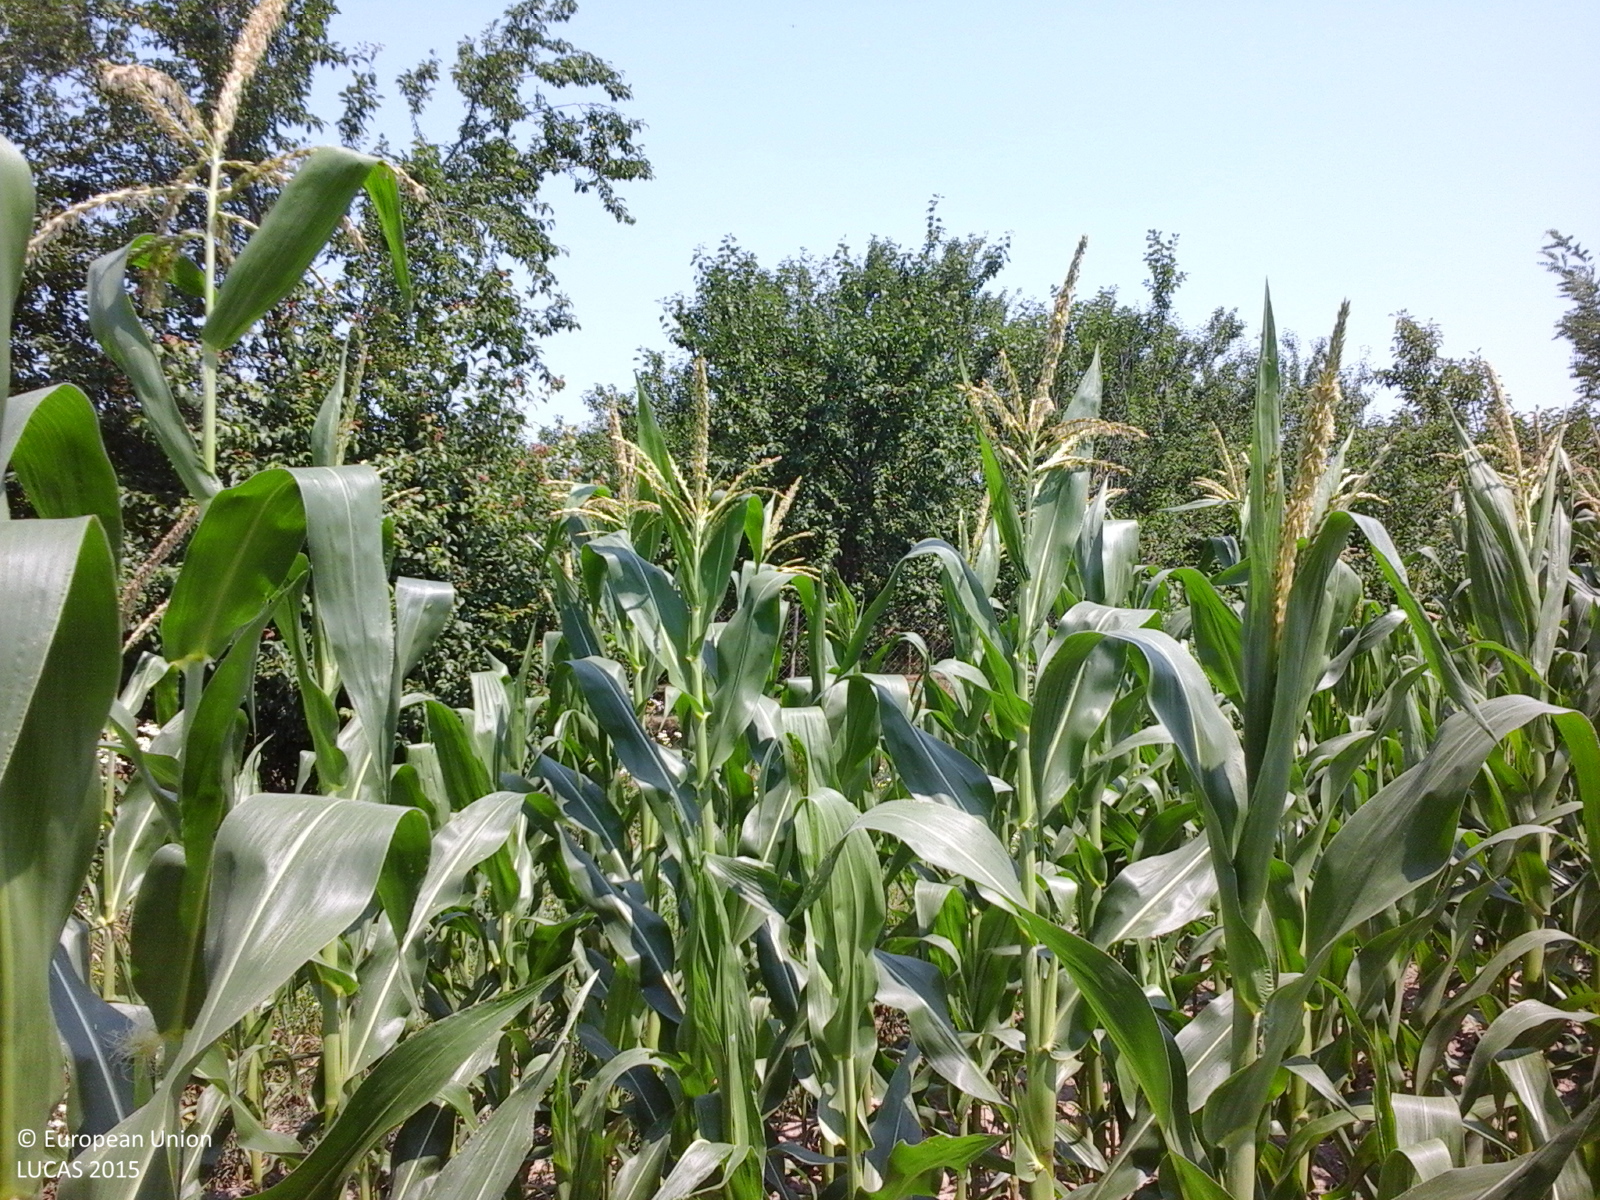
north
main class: Cropland
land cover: Maize
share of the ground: > 75 %
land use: Agriculture (excluding fallow land and kitchen gardens)
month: July
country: RO
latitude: 44.7469
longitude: 25.6713
